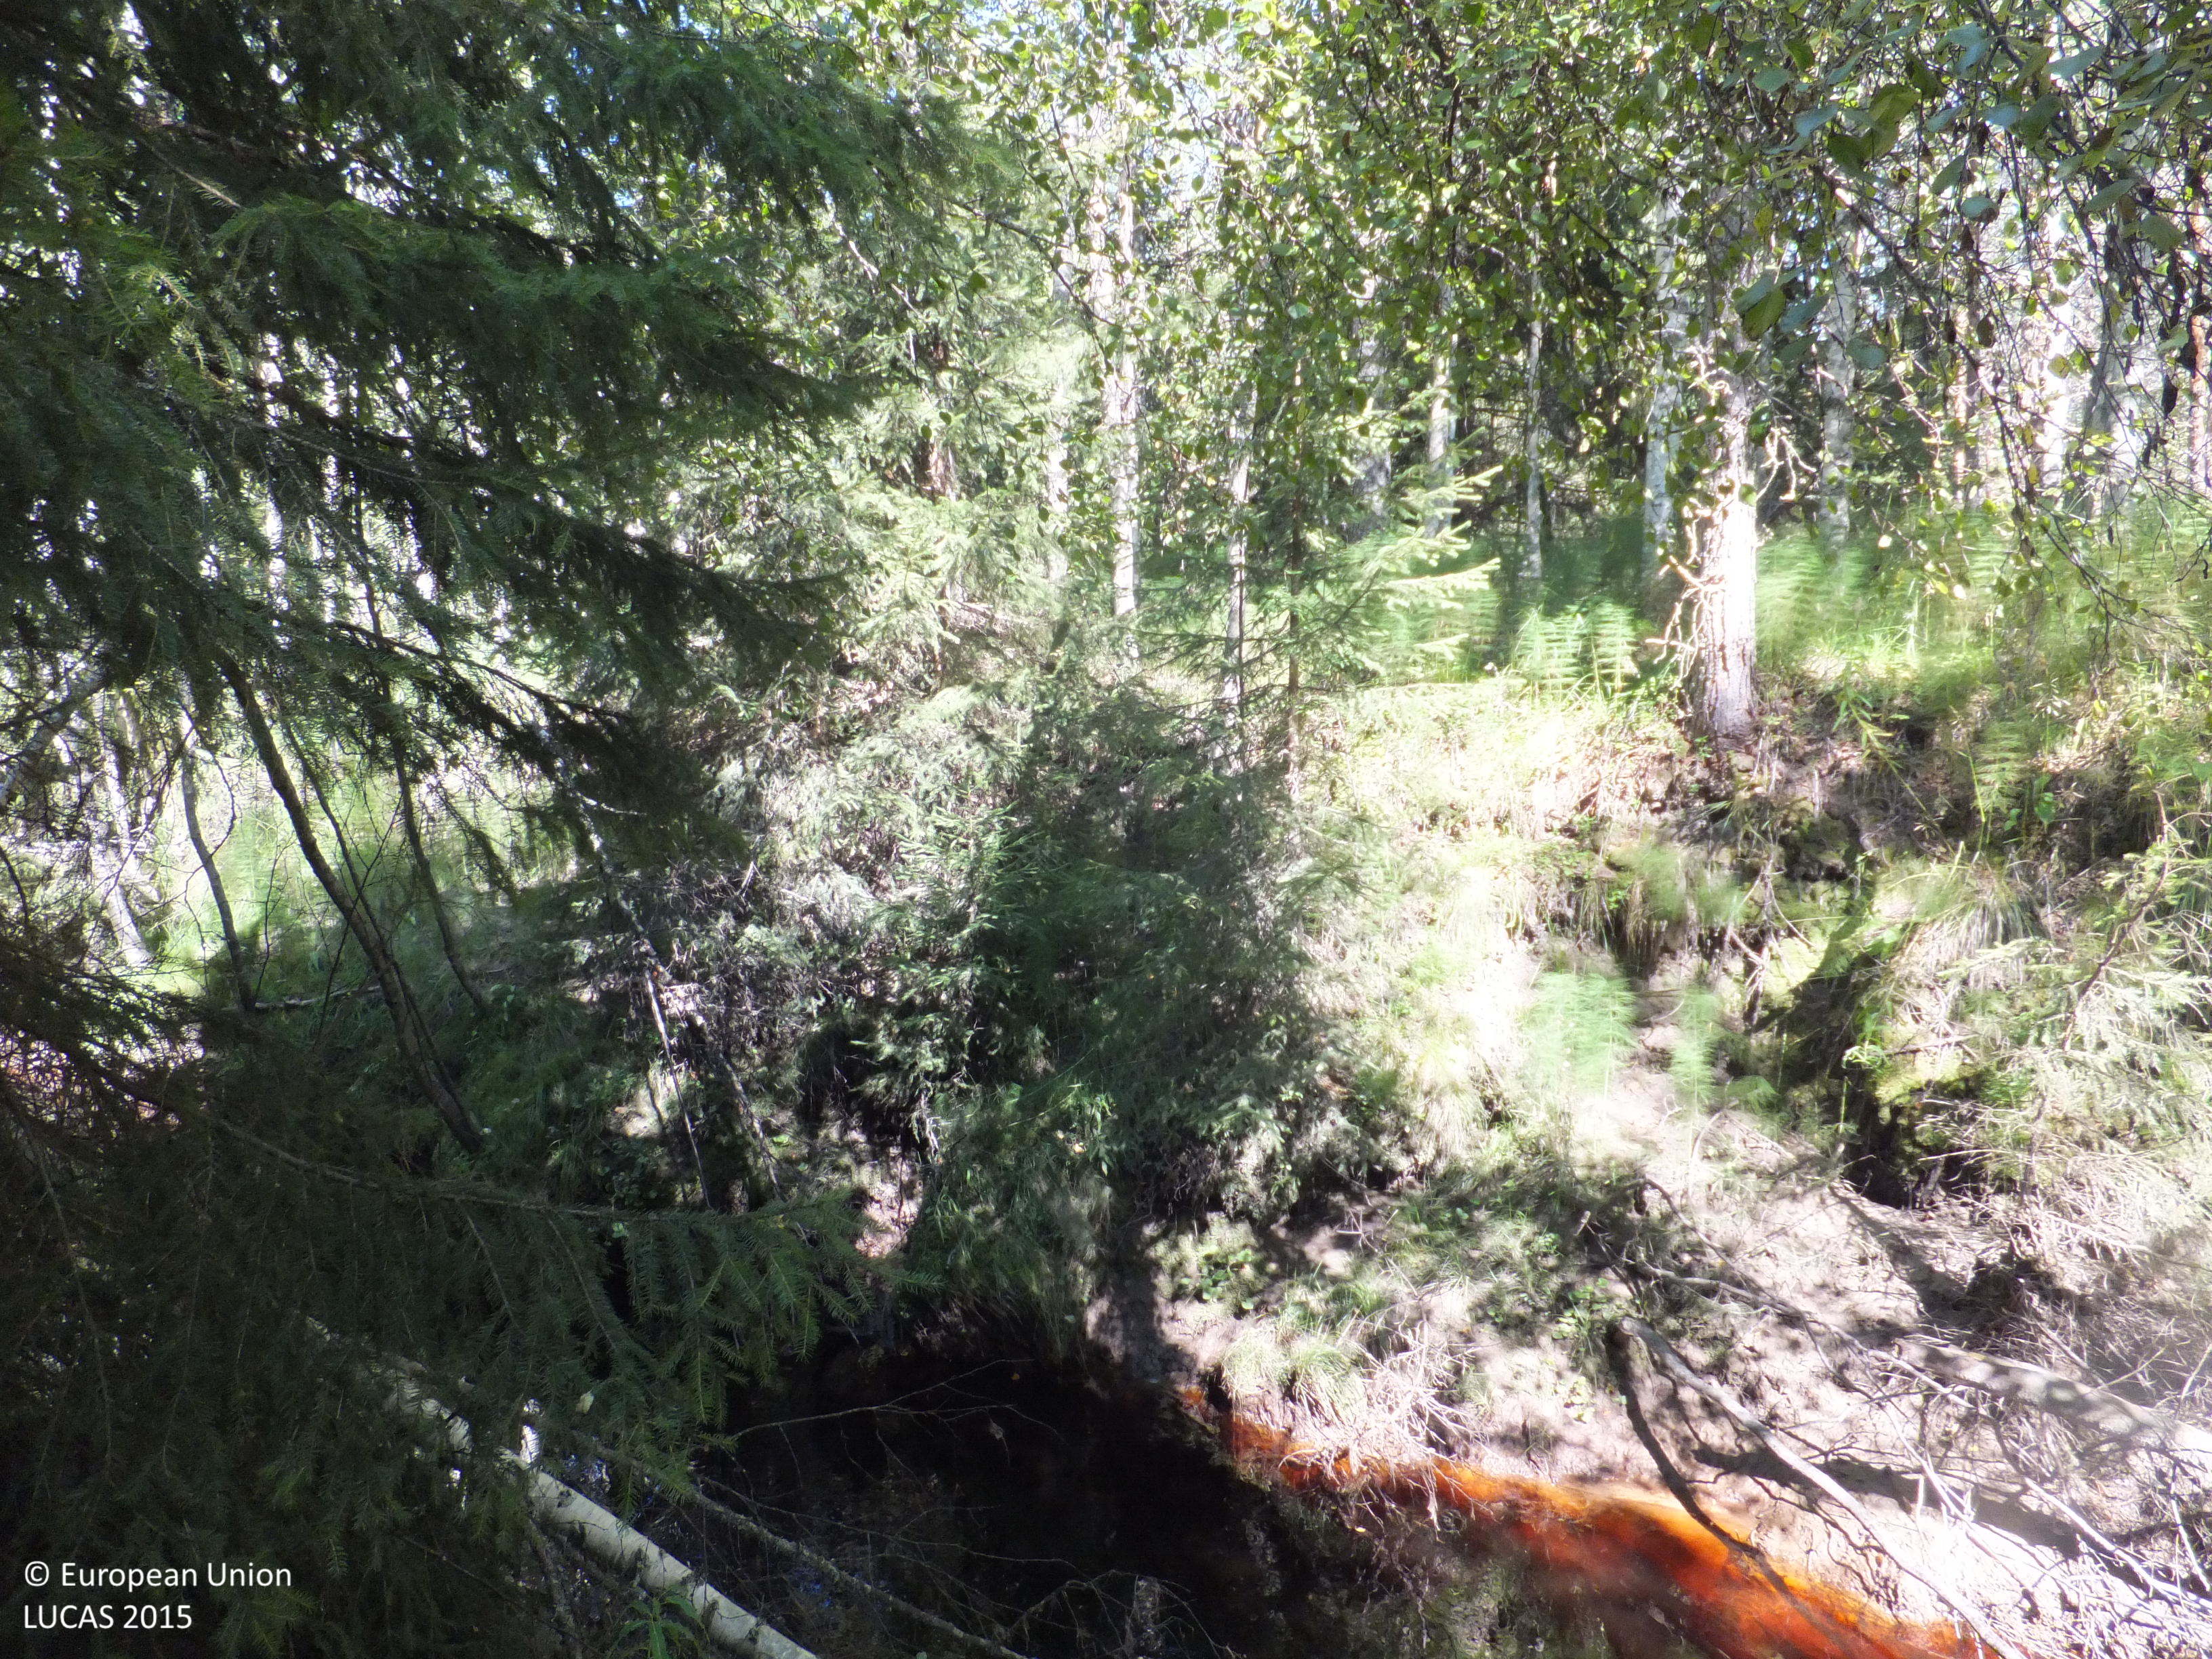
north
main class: Woodland
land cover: Spruce dominated mixed woodland
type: boreal forest
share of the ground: > 75 %
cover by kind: coniferous forest trees 40 %, broadleaved forest trees 40 %, herbaceous plants 10 %, lichens and mosses 5 %, unconsolidated bare surface 5 %
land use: Forestry
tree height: > 5 m
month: August
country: FI
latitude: 63.1138
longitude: 23.3631
